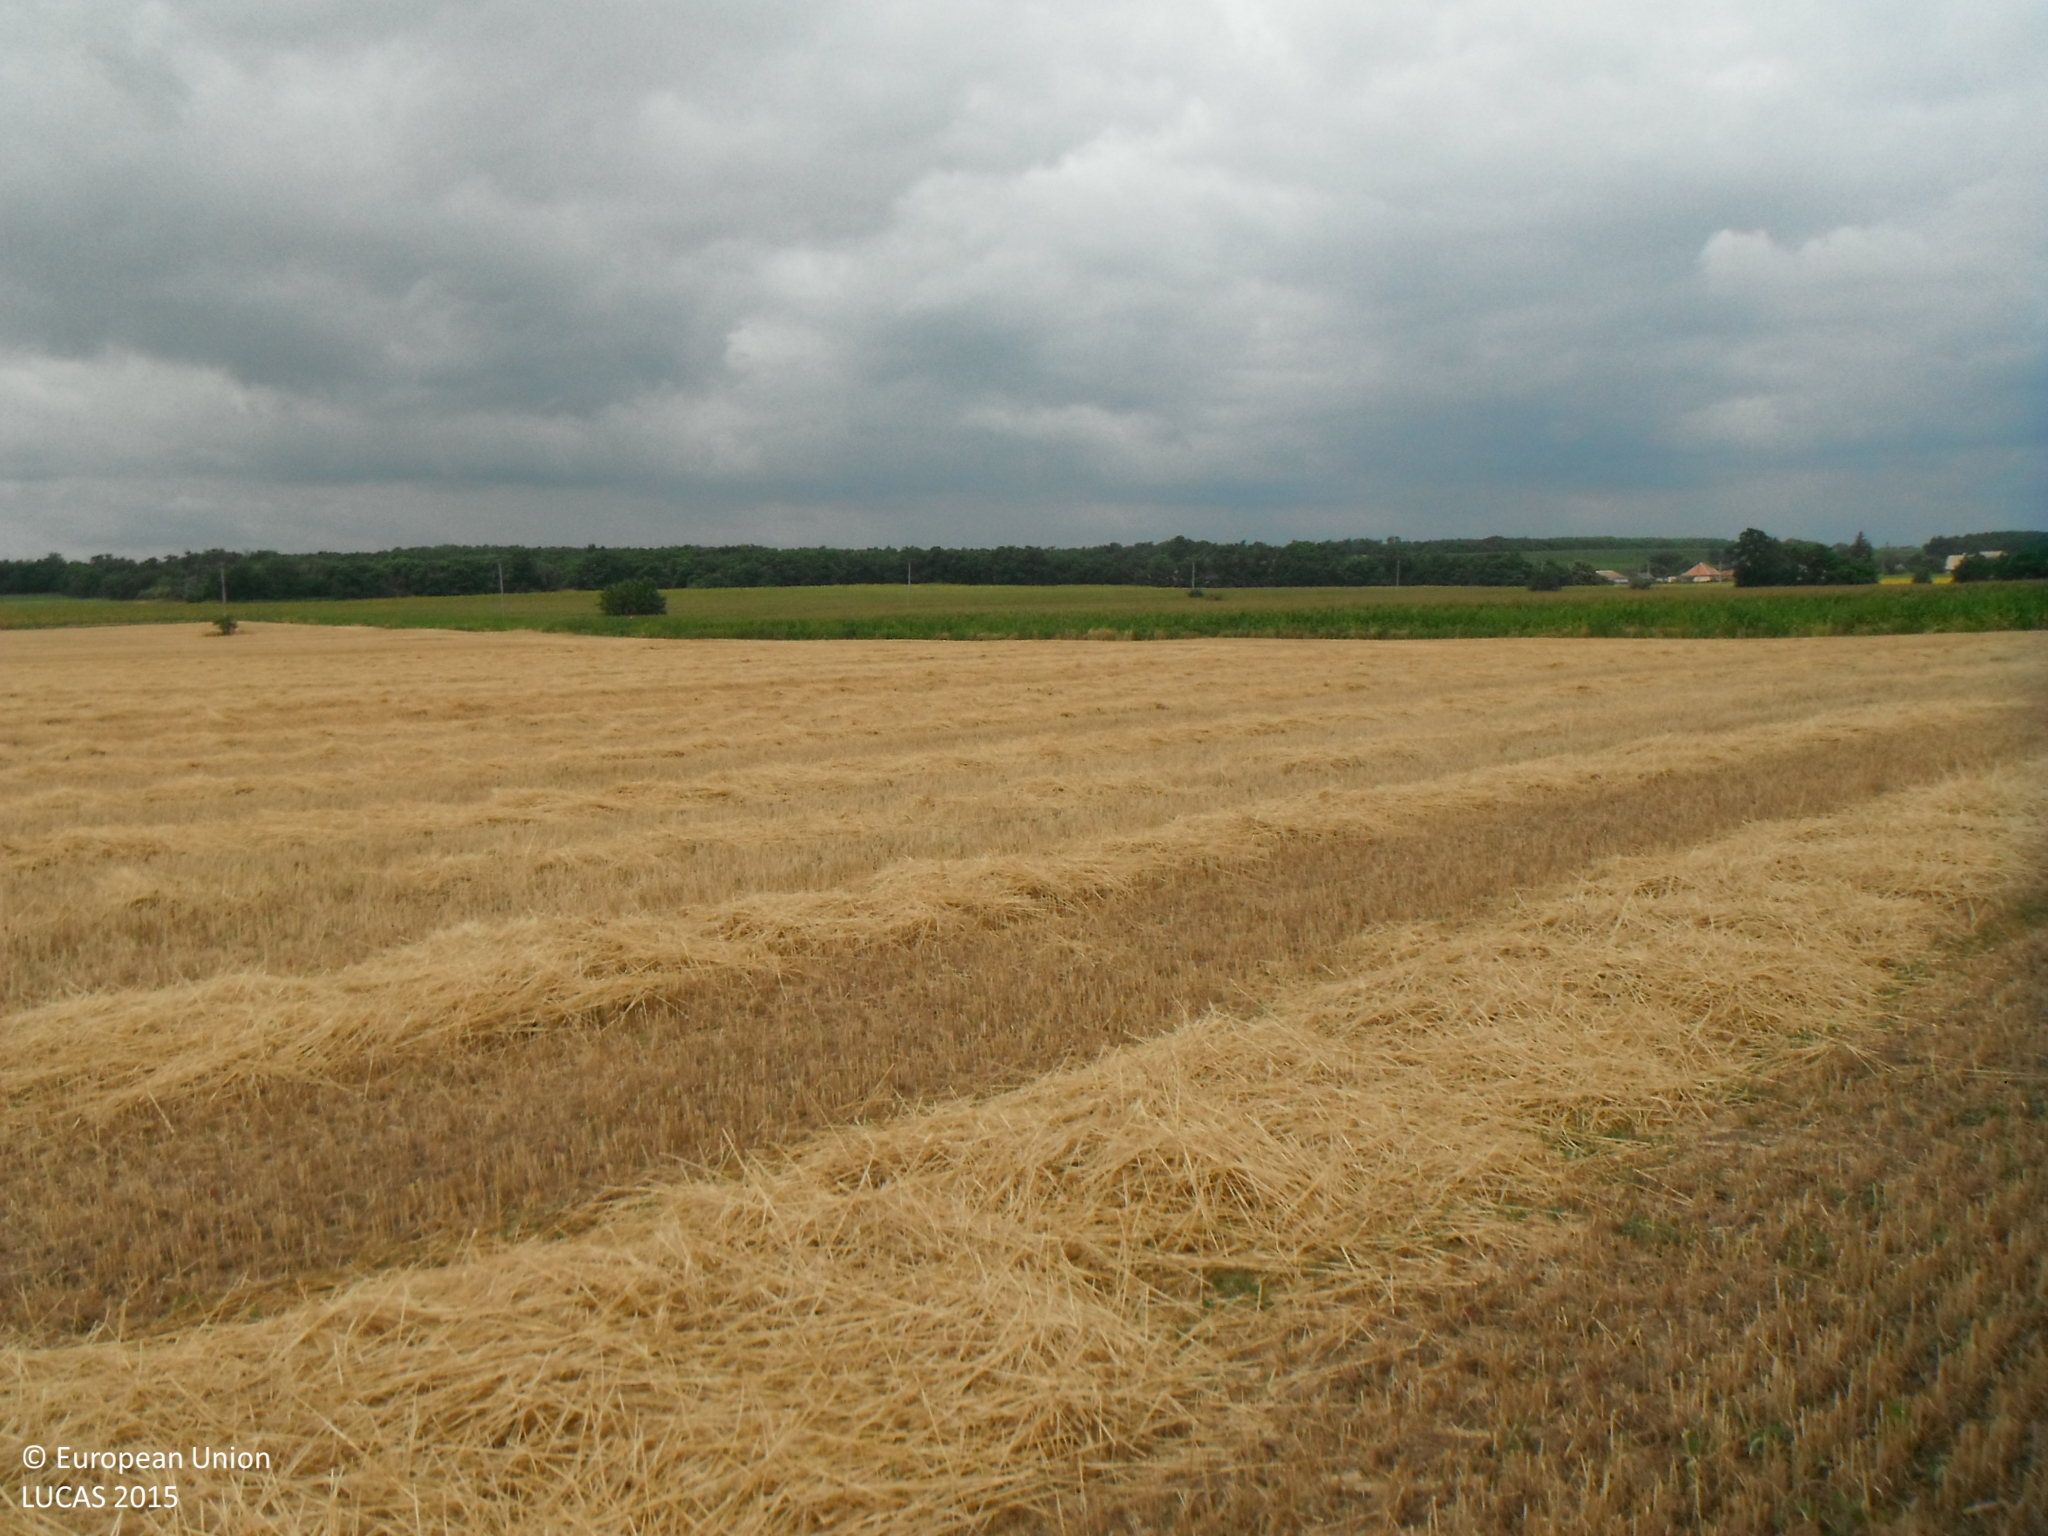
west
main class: Cropland
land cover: Common wheat
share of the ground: > 75 %
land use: Agriculture (excluding fallow land and kitchen gardens)
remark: Harvested field
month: July
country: SK
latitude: 47.8589
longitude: 18.2605
